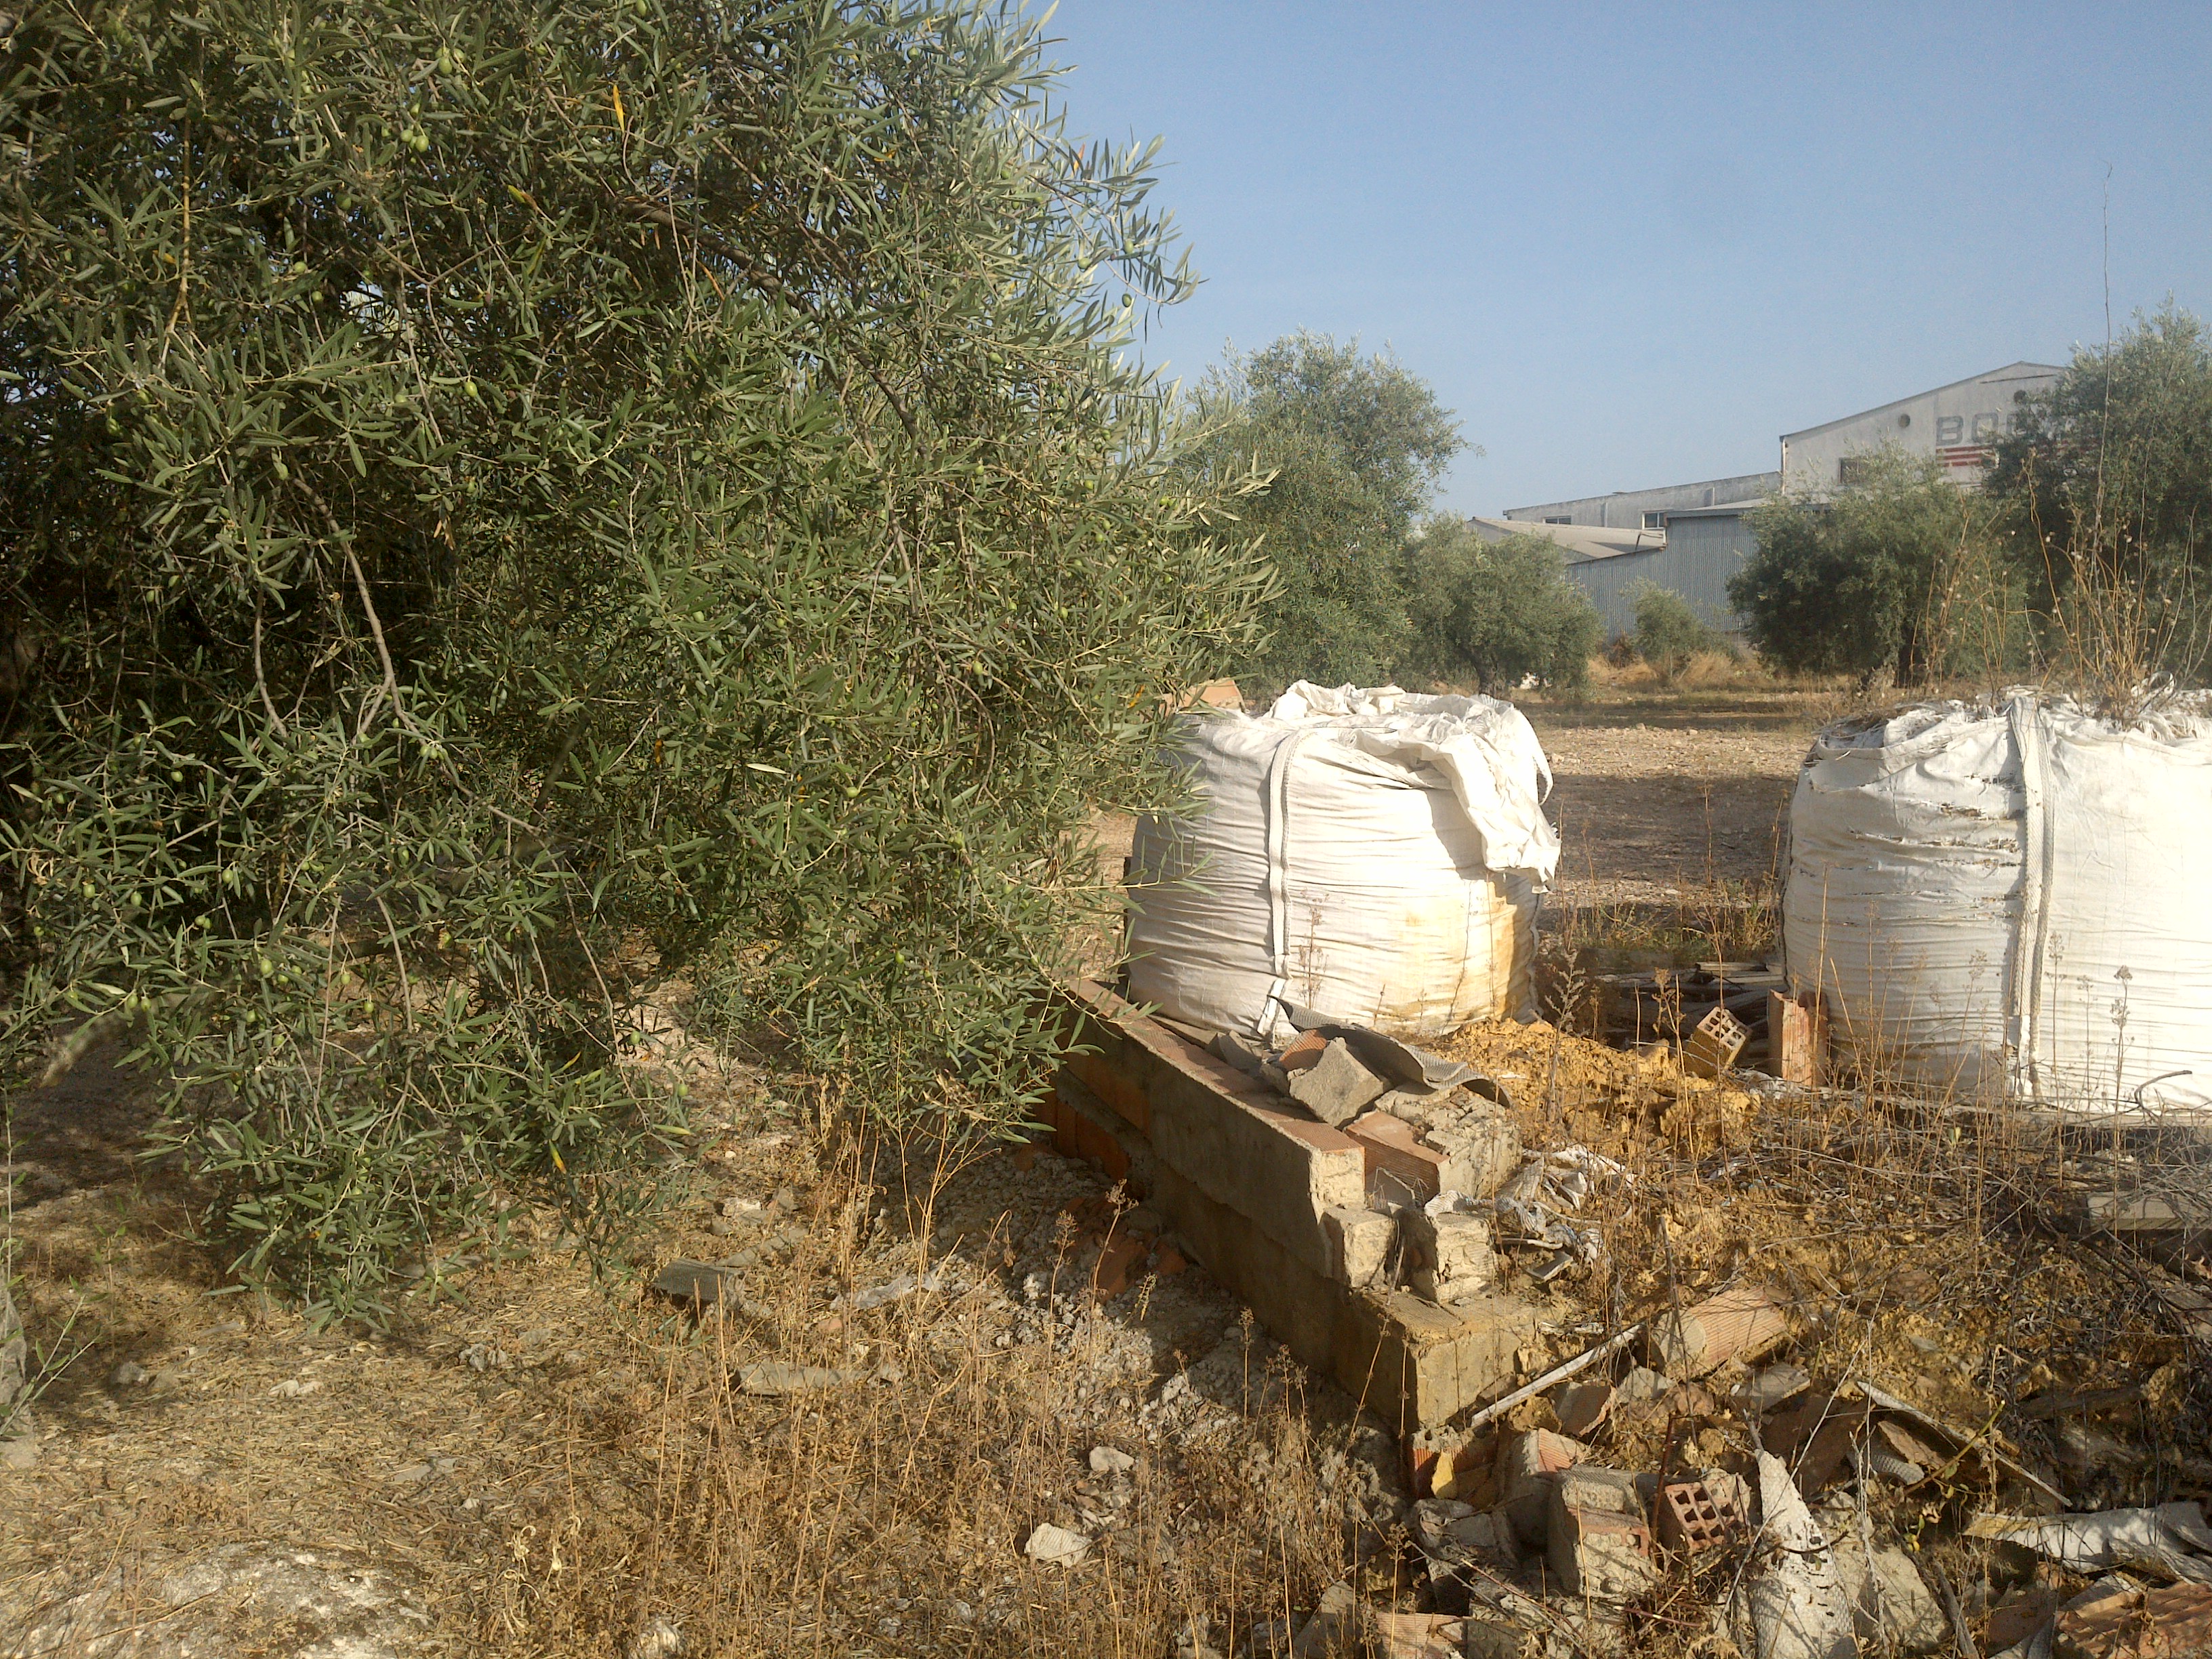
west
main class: Cropland
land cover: Olive groves
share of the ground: 25 - 50 %
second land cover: Spontaneously vegetated surfaces
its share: 25 - 50 %
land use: Agriculture (excluding fallow land and kitchen gardens)
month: July
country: ES
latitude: 37.3671
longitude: -4.4890
